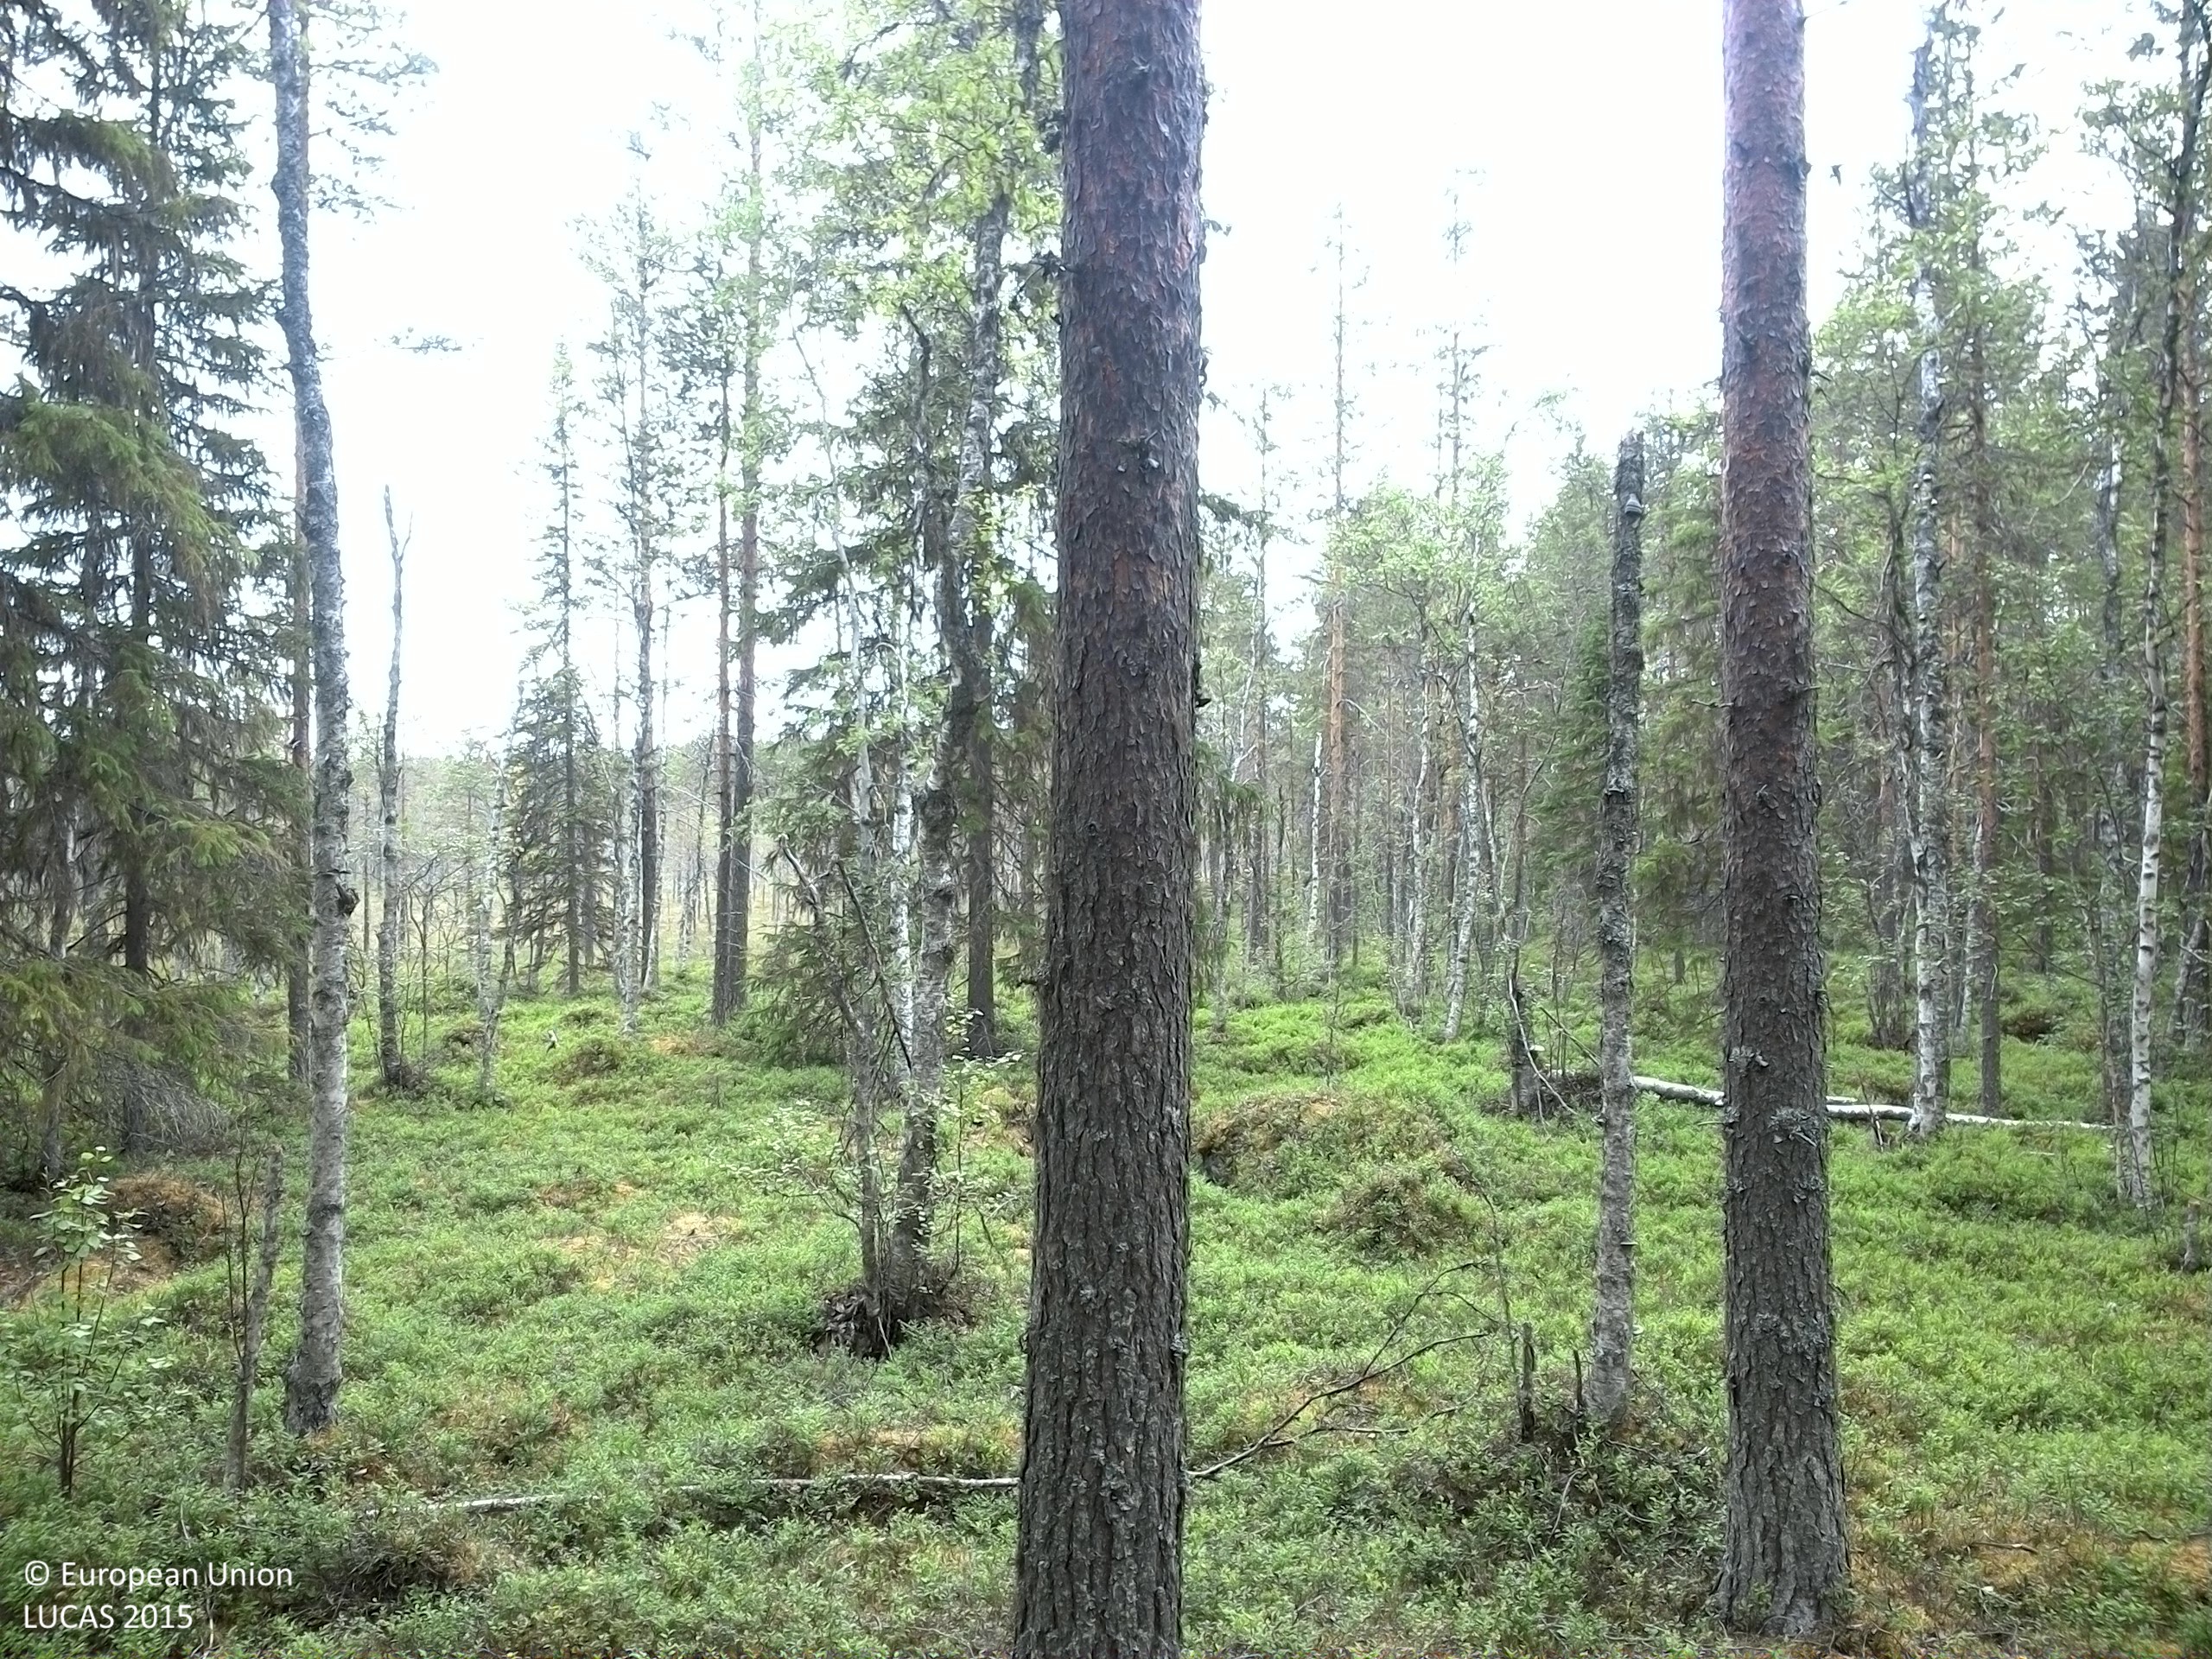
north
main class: Woodland
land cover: Pine dominated mixed woodland
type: boreal forest
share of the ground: 50 - 75 %
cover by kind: coniferous forest trees 40 %, shrubs 30 %, broadleaved forest trees 15 %, lichens and mosses 15 %
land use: Forestry
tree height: > 5 m
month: July
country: SE
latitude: 63.6400
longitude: 17.5027
